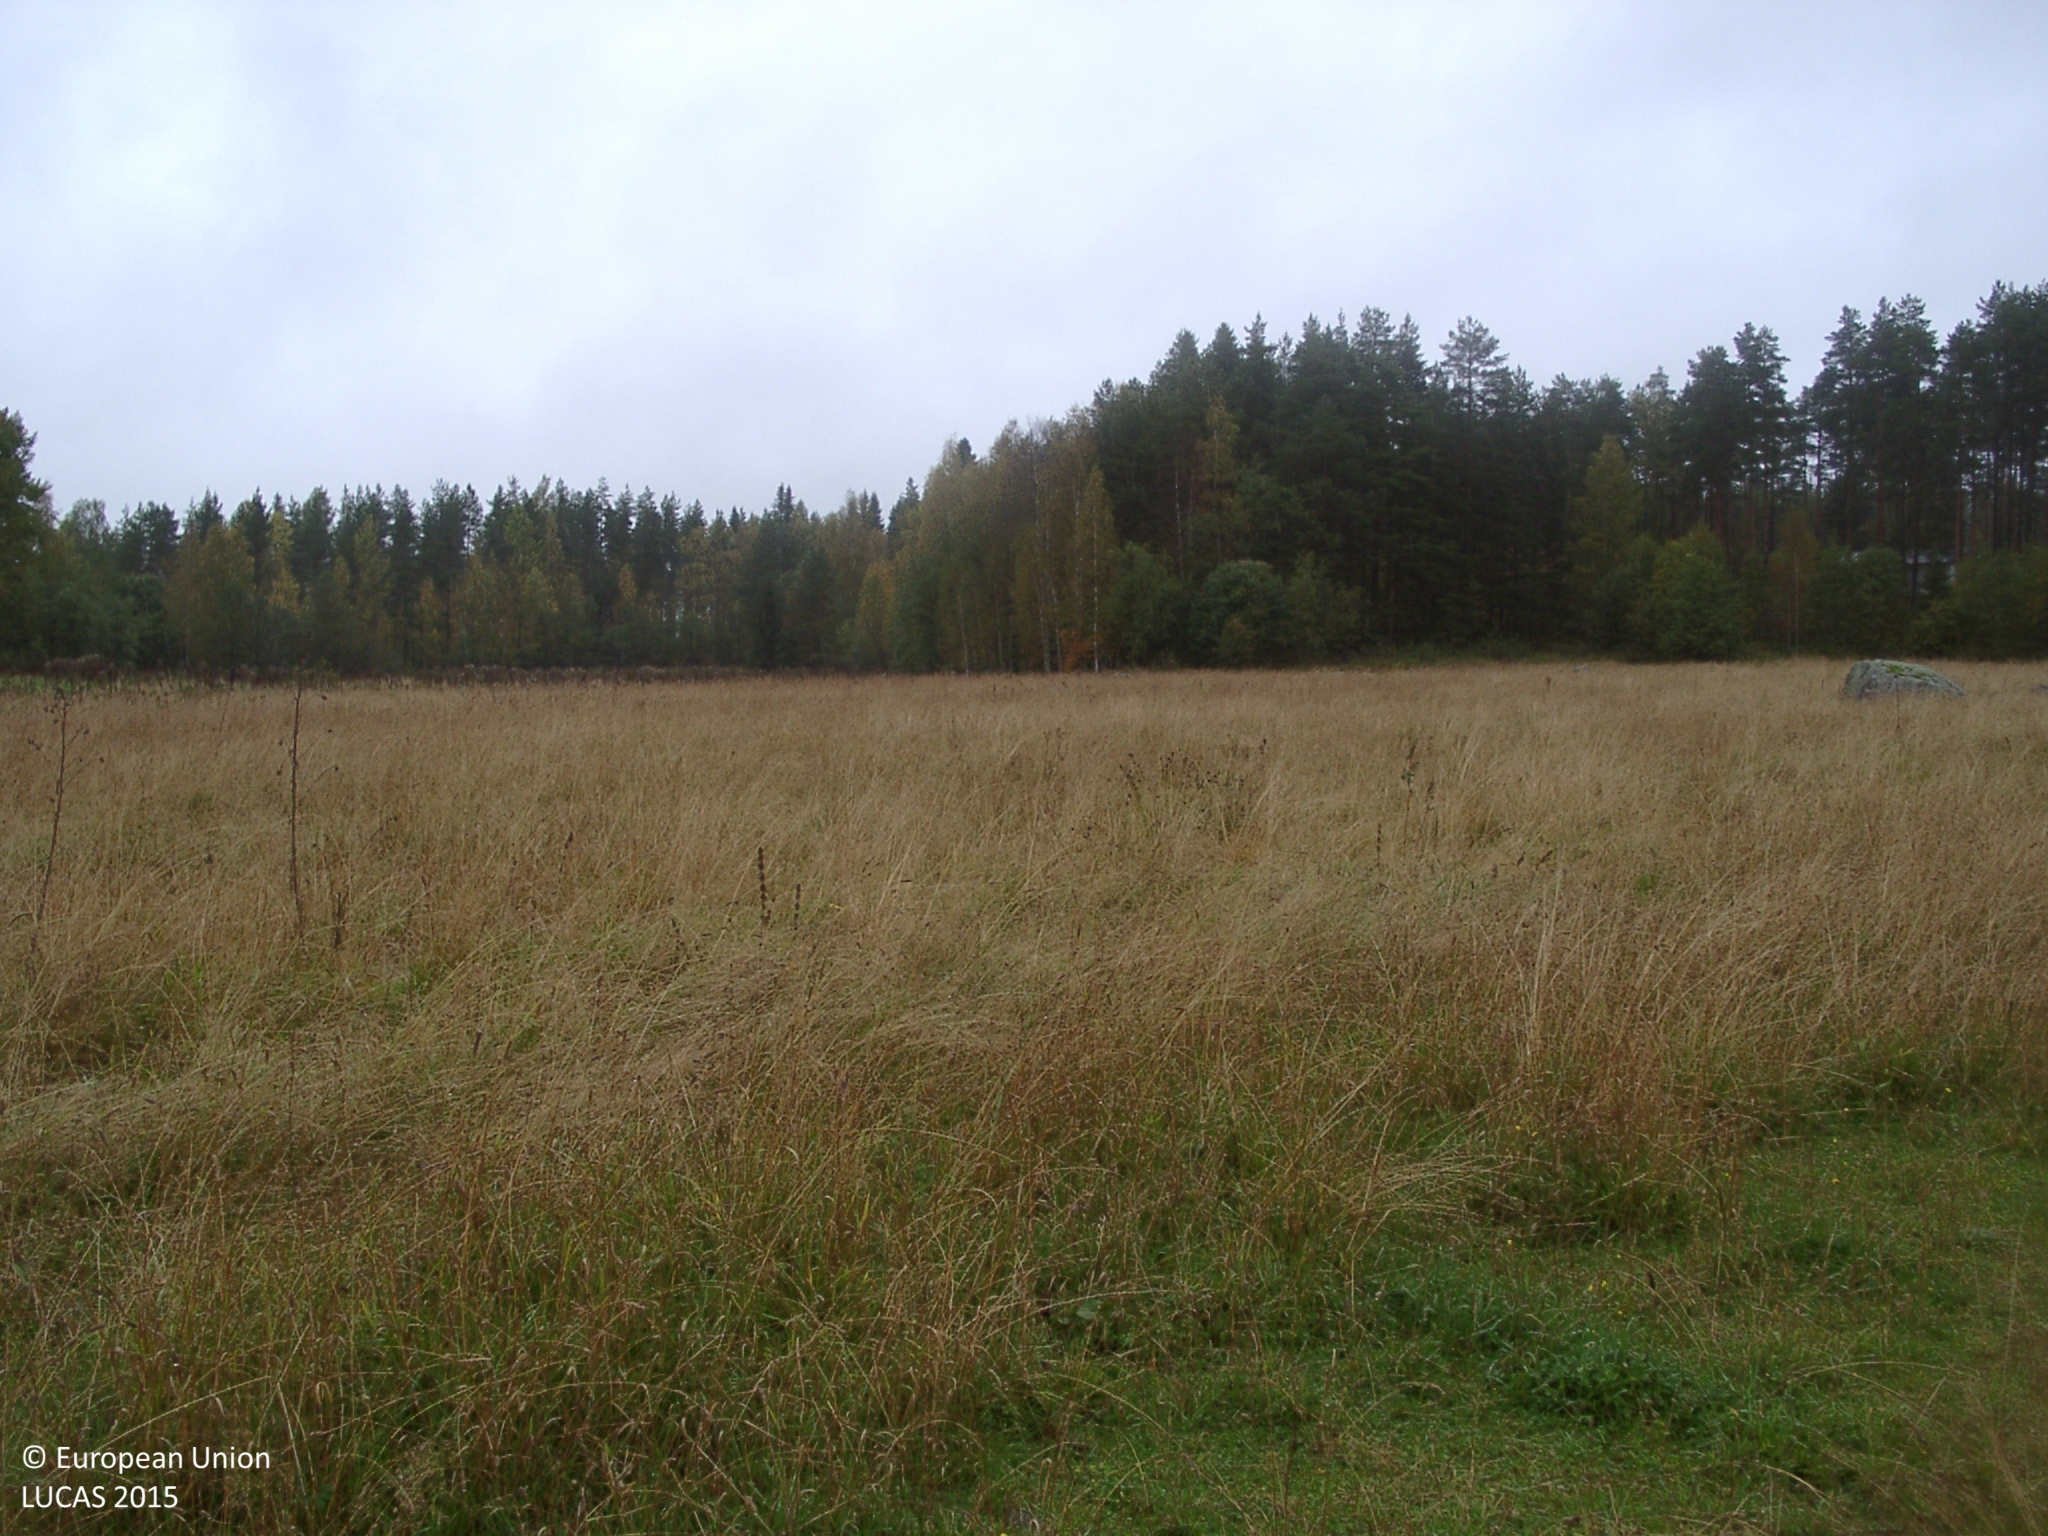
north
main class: Grassland
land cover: Grassland without tree/shrub cover
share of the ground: > 75 %
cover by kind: herbaceous plants 100 %
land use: Agriculture (excluding fallow land and kitchen gardens)
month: September
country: FI
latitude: 62.7595
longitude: 25.5214
